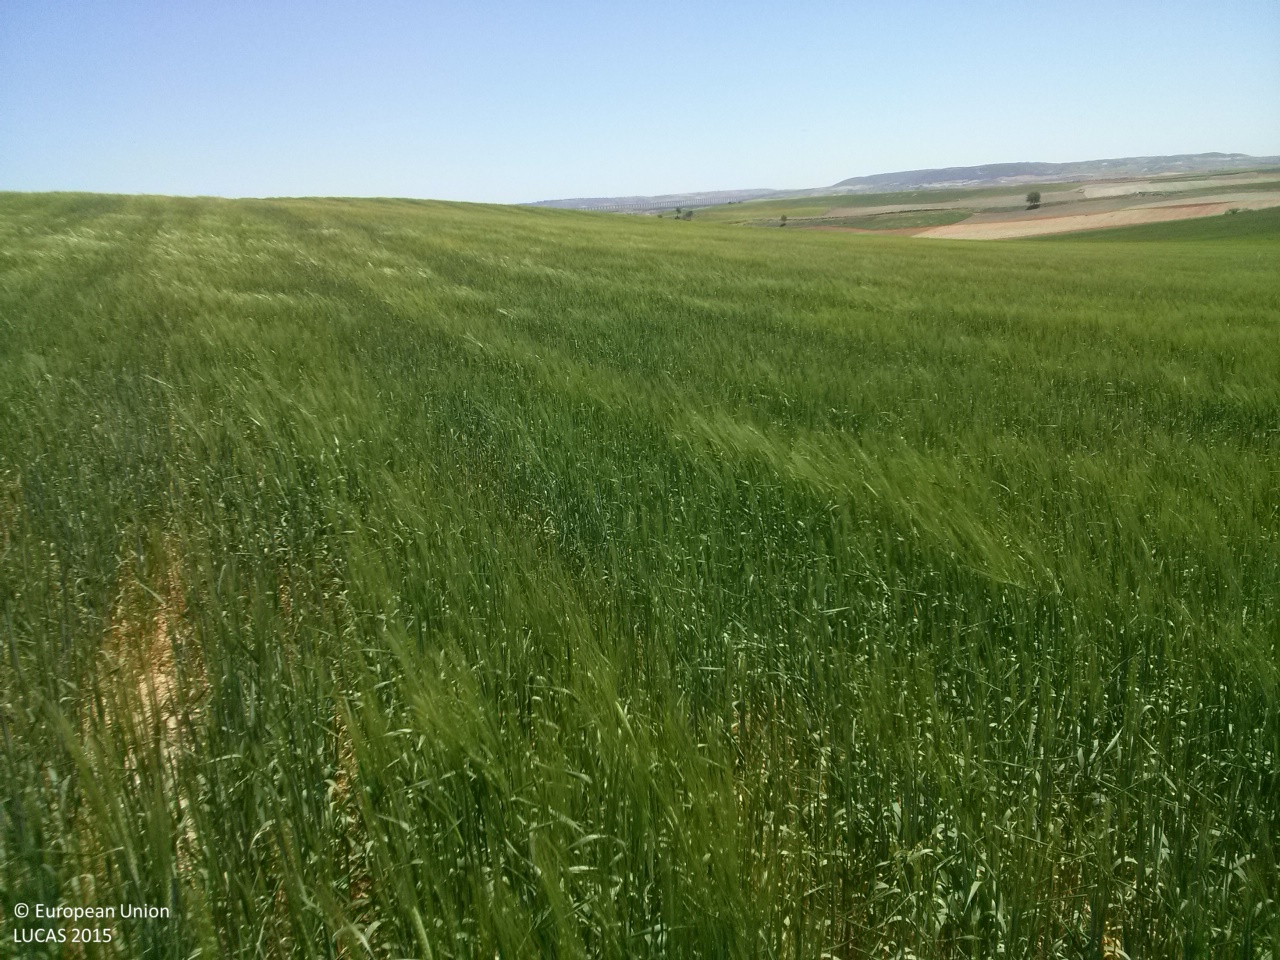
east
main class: Cropland
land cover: Barley
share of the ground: > 75 %
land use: Agriculture (excluding fallow land and kitchen gardens)
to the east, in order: Barley; Dry pulses
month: May
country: ES
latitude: 39.9598
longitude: -2.7689
